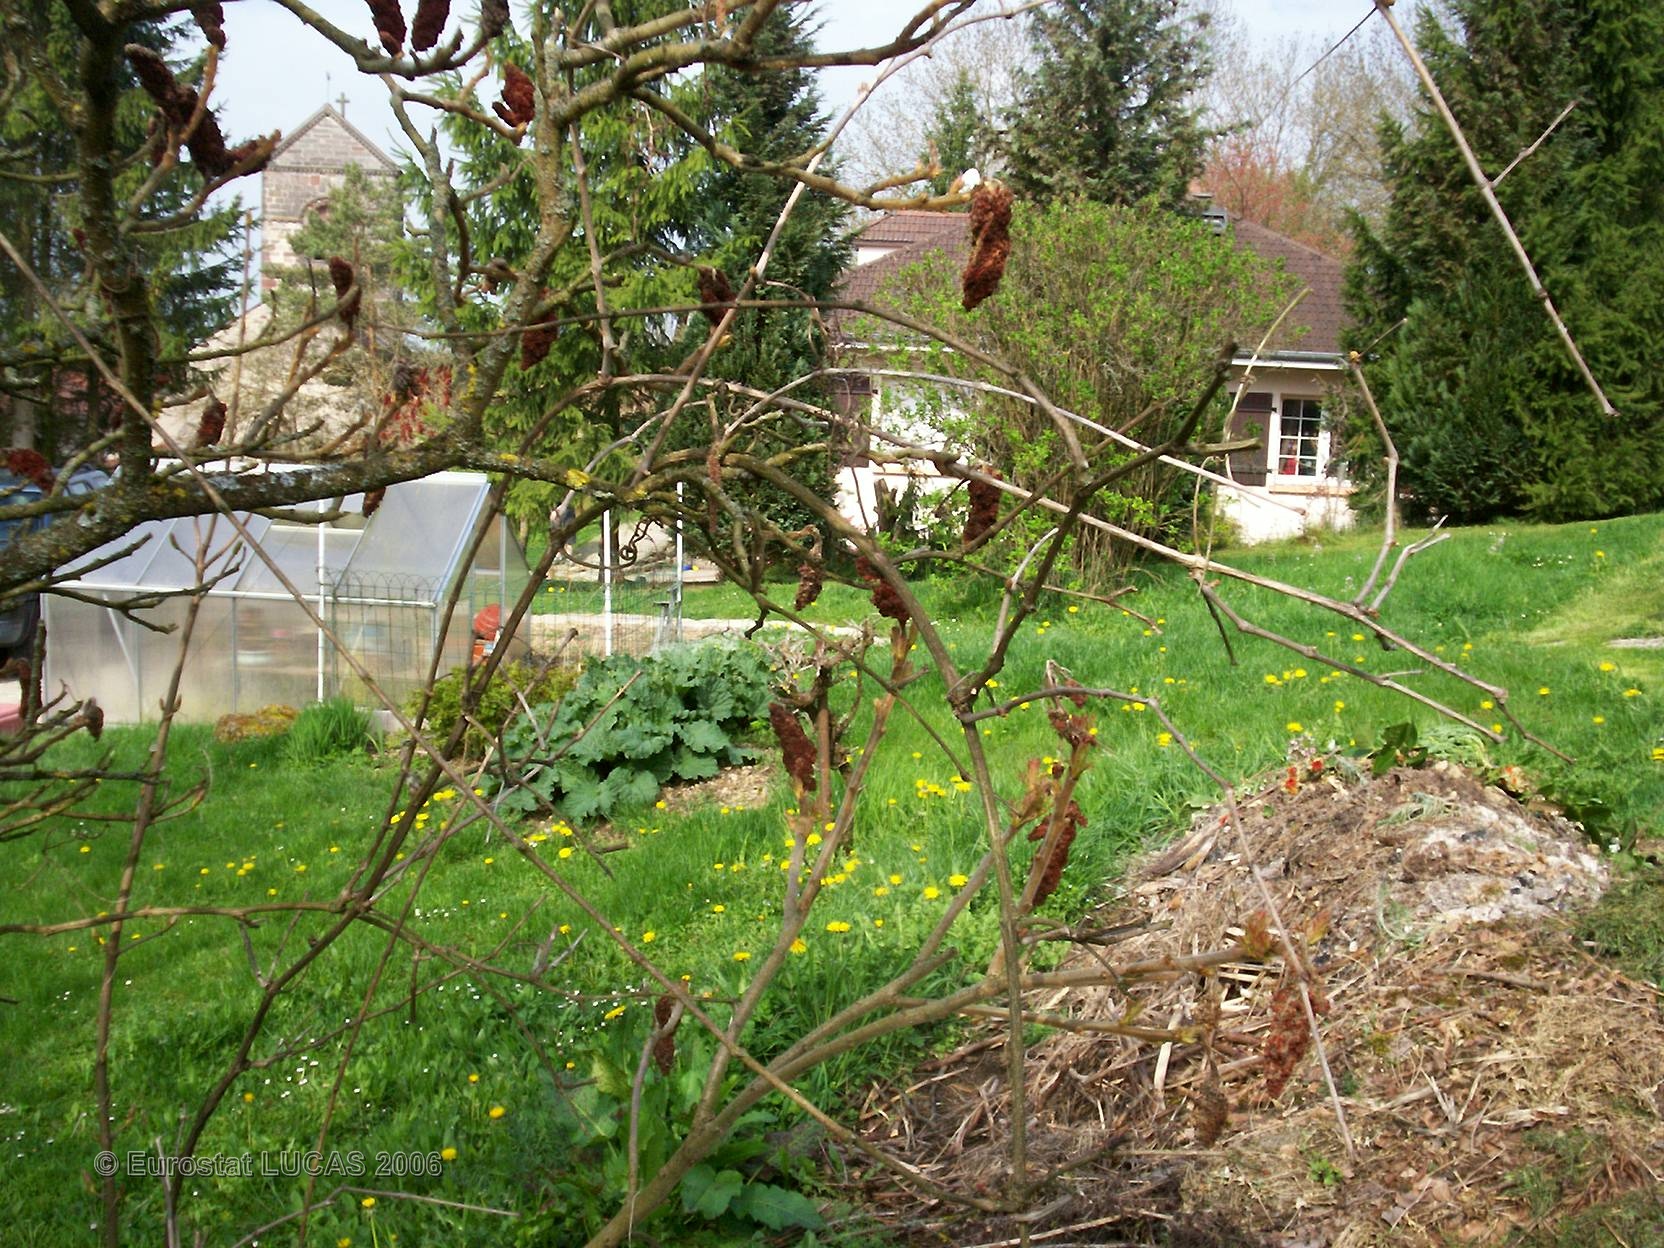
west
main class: Grassland
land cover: Grassland with sparse tree/shrub cover
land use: Residential
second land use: Kitchen garden
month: April
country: FR
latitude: 48.1673
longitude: 5.9531
